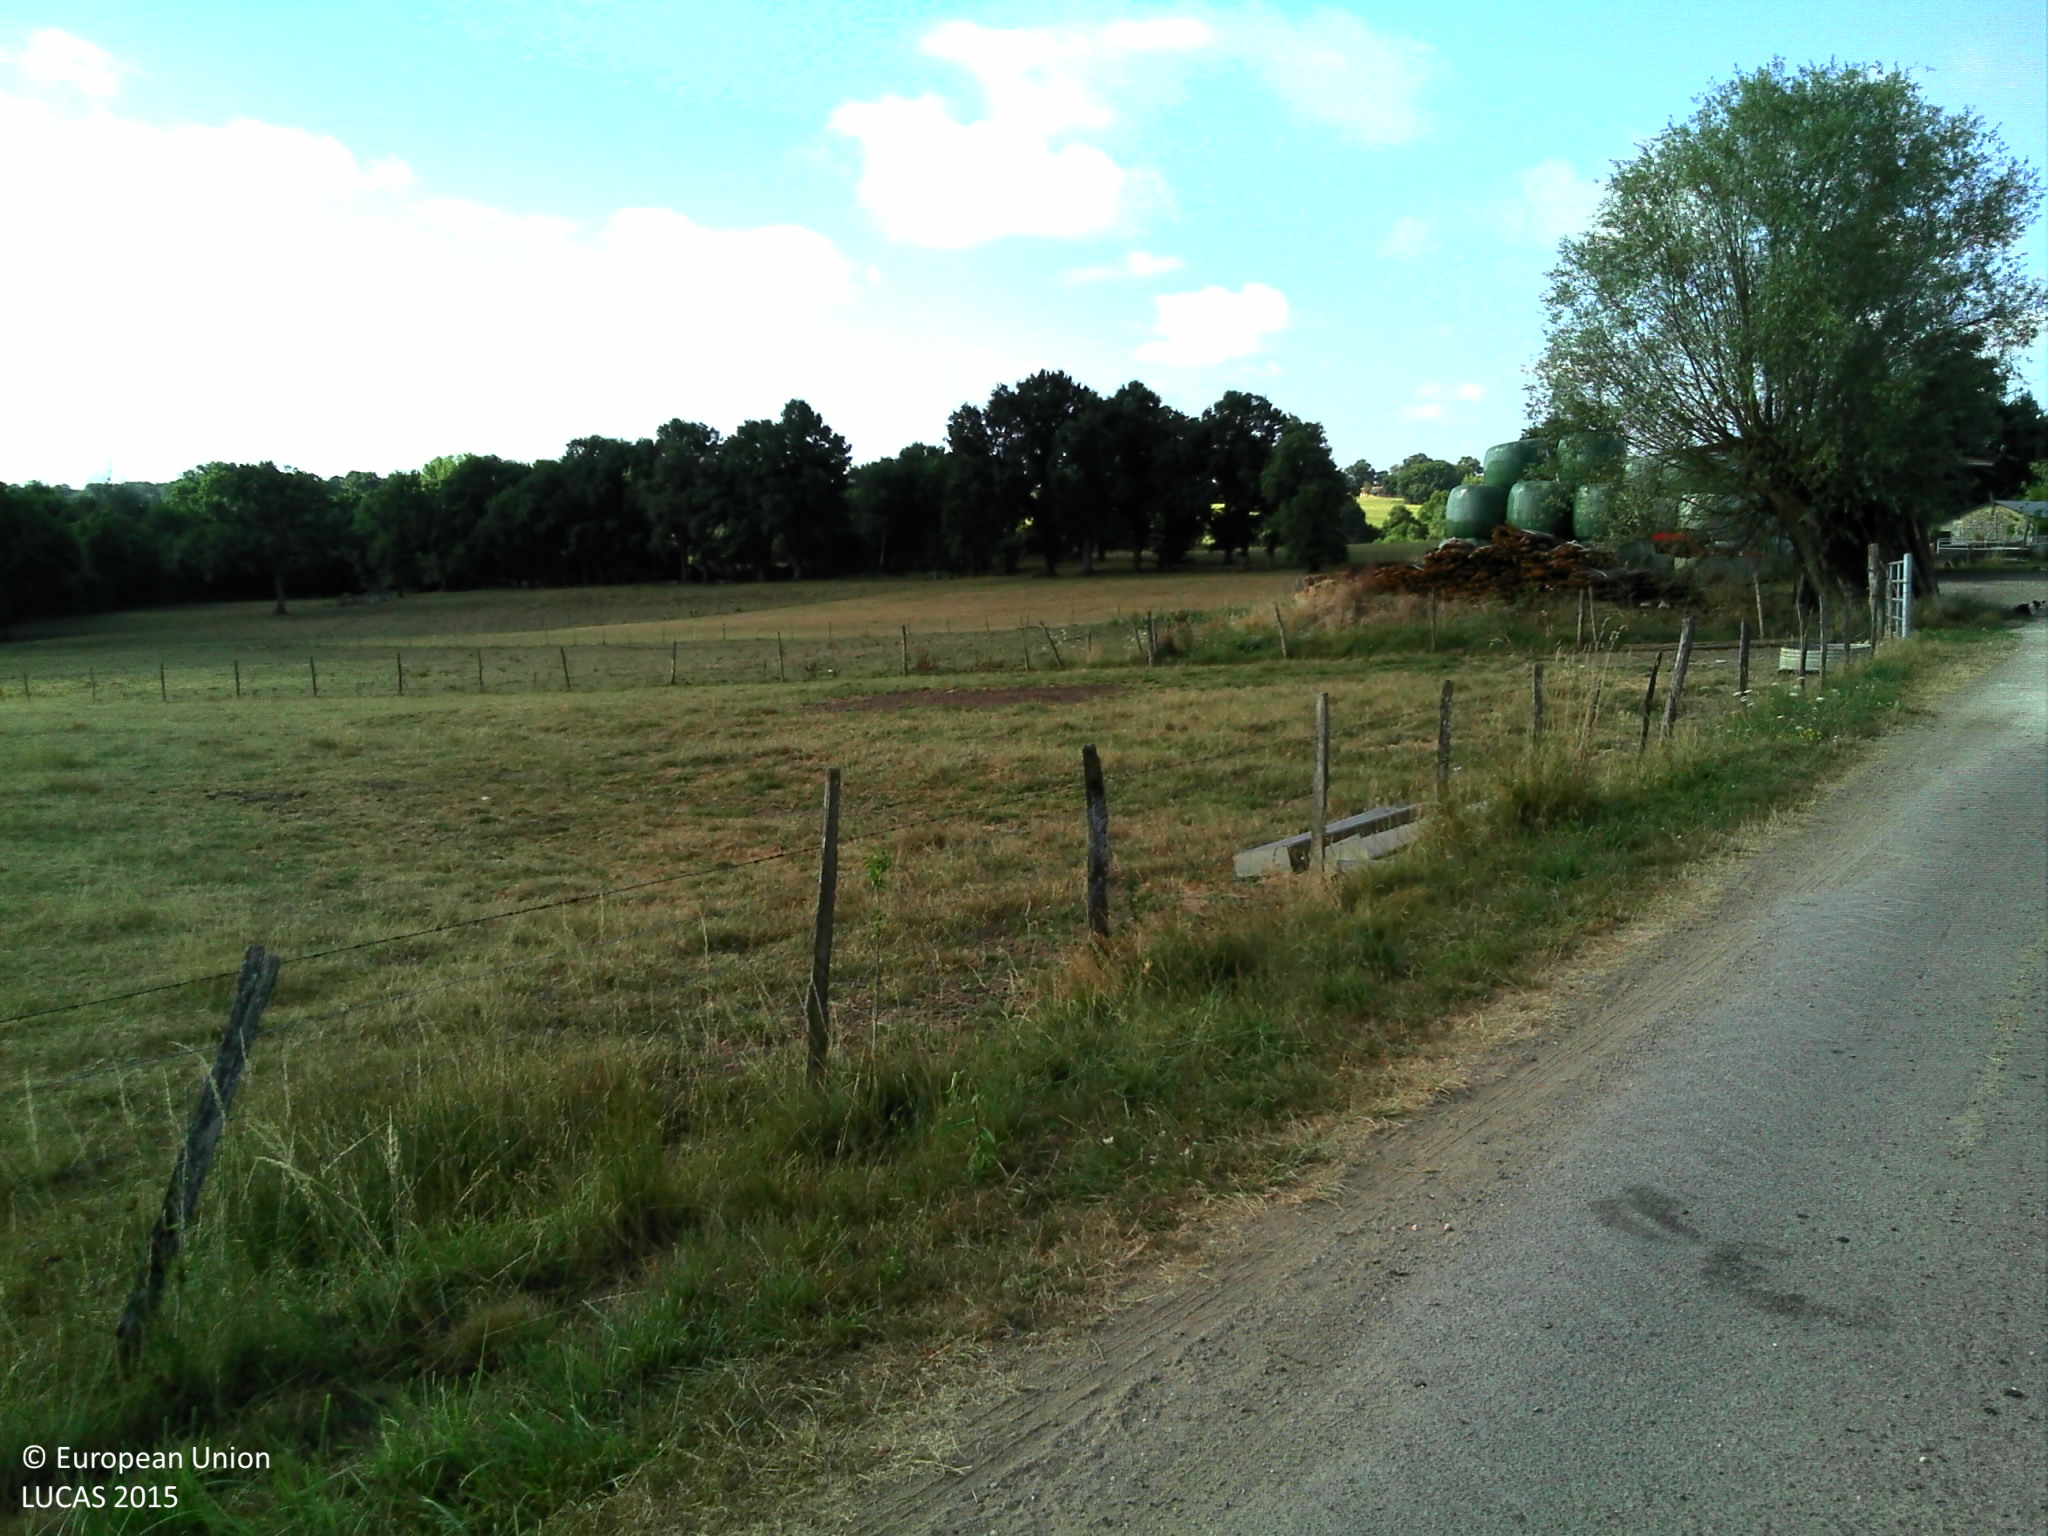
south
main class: Grassland
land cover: Grassland without tree/shrub cover
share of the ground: > 75 %
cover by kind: herbaceous plants 100 %
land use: Agriculture (excluding fallow land and kitchen gardens)
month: July
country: FR
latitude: 46.2183
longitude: 0.5075
